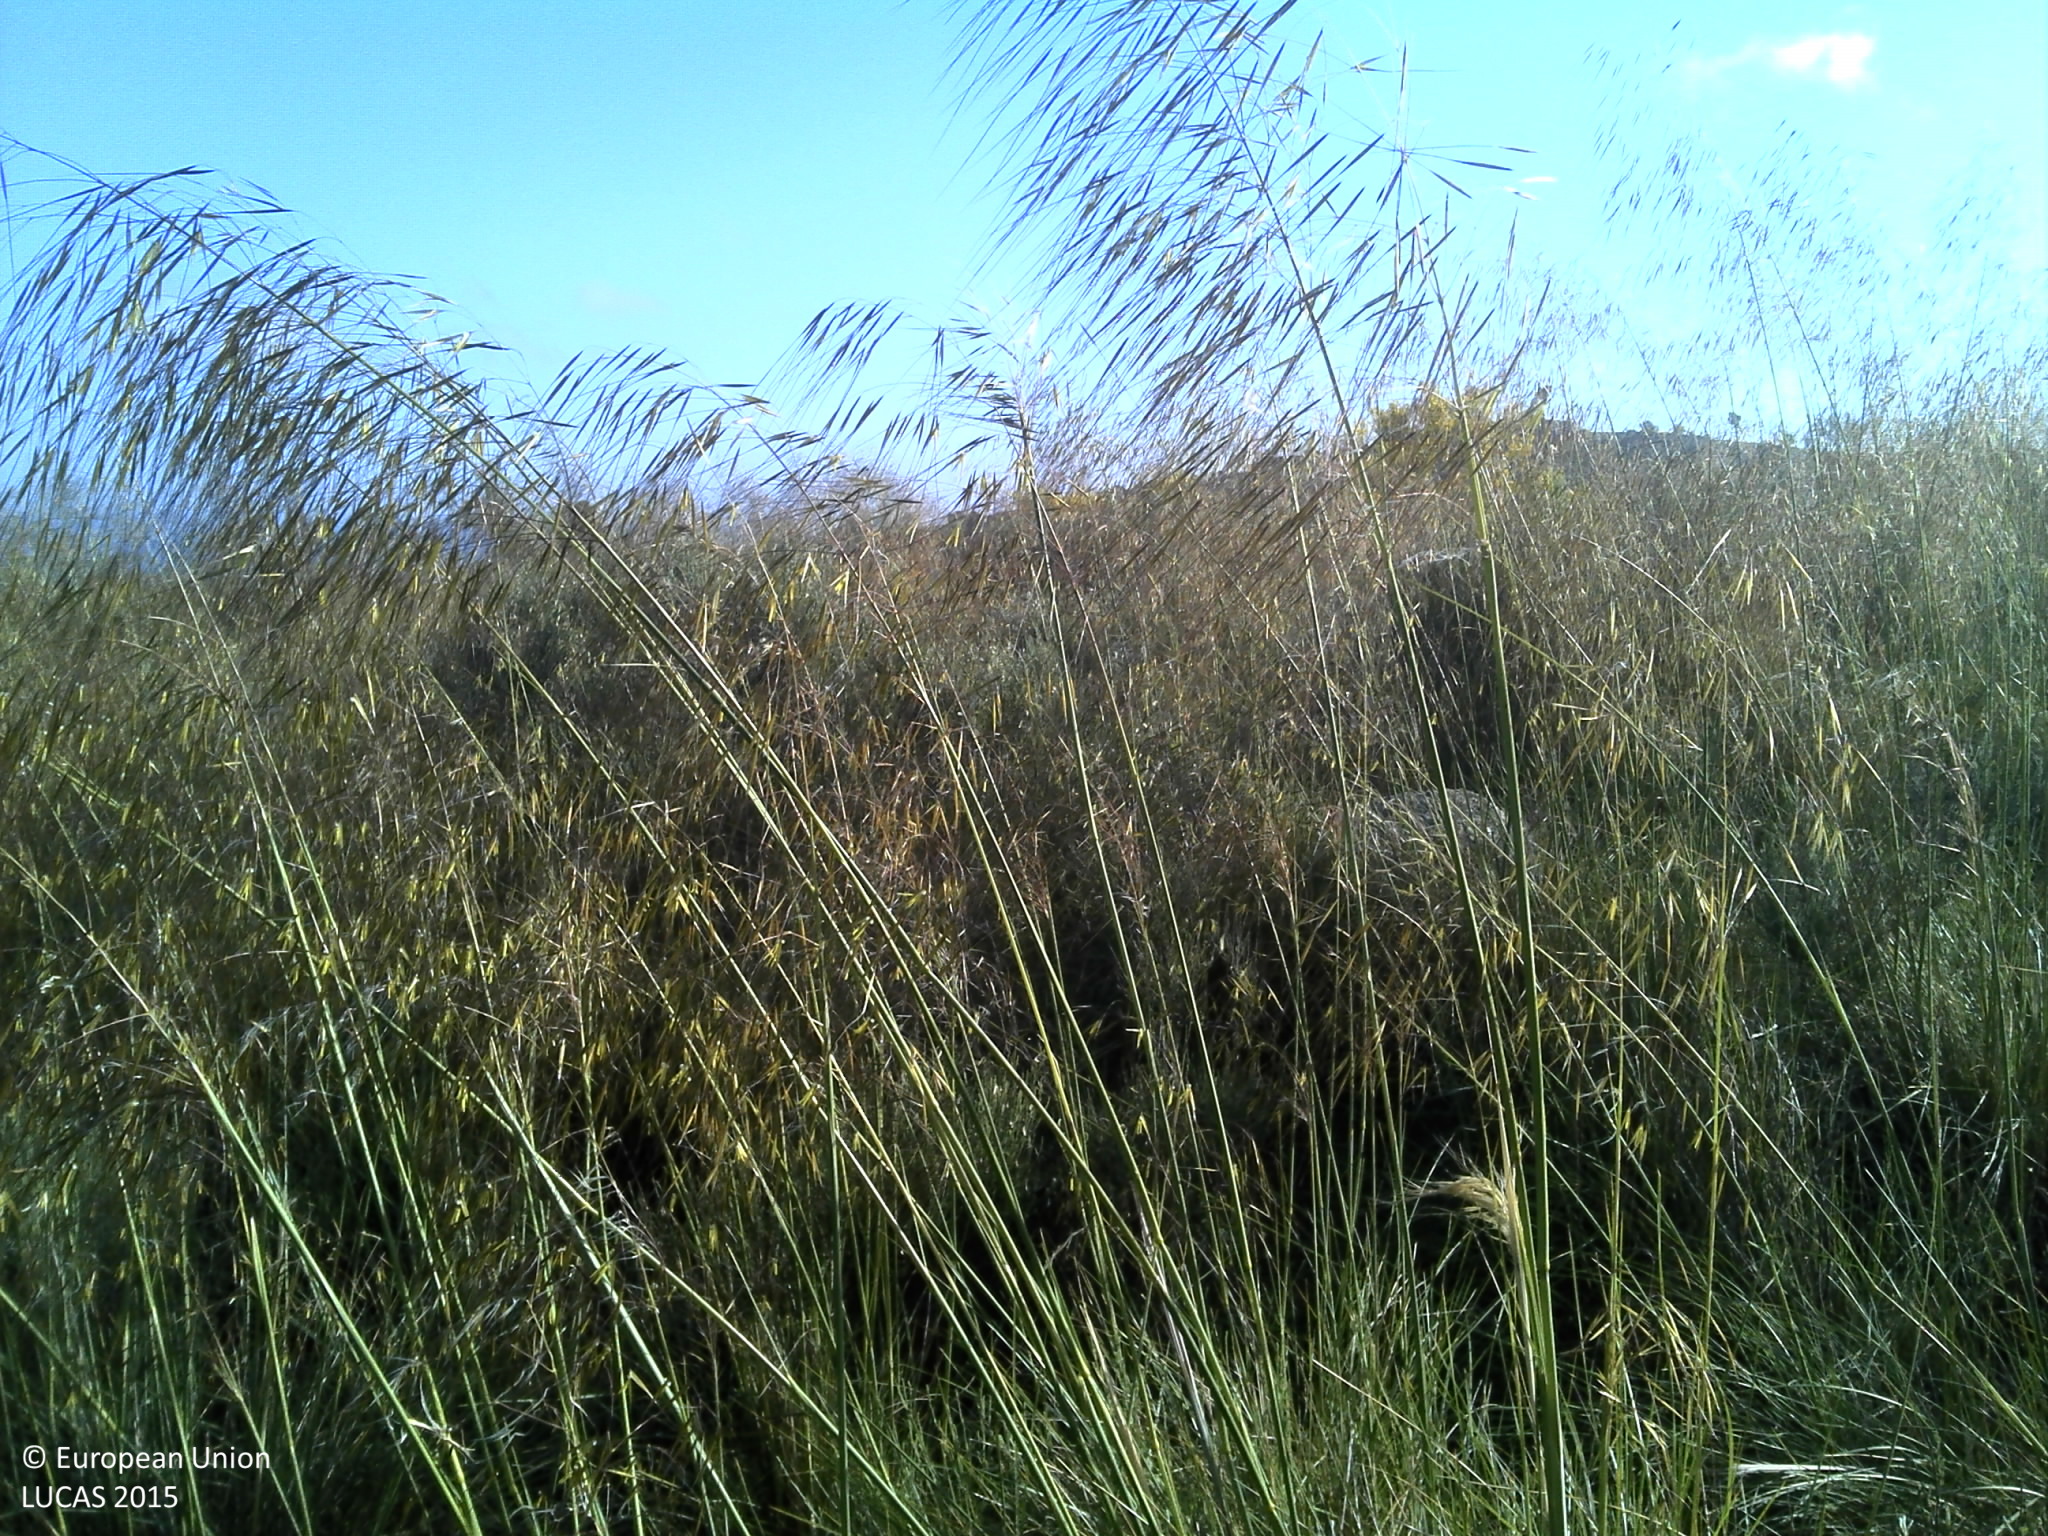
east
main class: Shrubland
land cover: Shrubland without tree cover
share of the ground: 50 - 75 %
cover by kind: shrubs 80 %, herbaceous plants 15 %
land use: Semi-natural and natural areas not in use
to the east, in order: Shrubland without tree cover; Dry stone walls; Shrubland without tree cover; Dry stone walls; Shrubland without tree cover; Dry stone walls; Shrubland without tree cover; Tracks; Shrubland without tree cover; Dry stone walls; Shrubland without tree cover; Tracks; Shrubland without tree cover
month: May
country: PT
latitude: 40.5852
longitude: -7.2736
